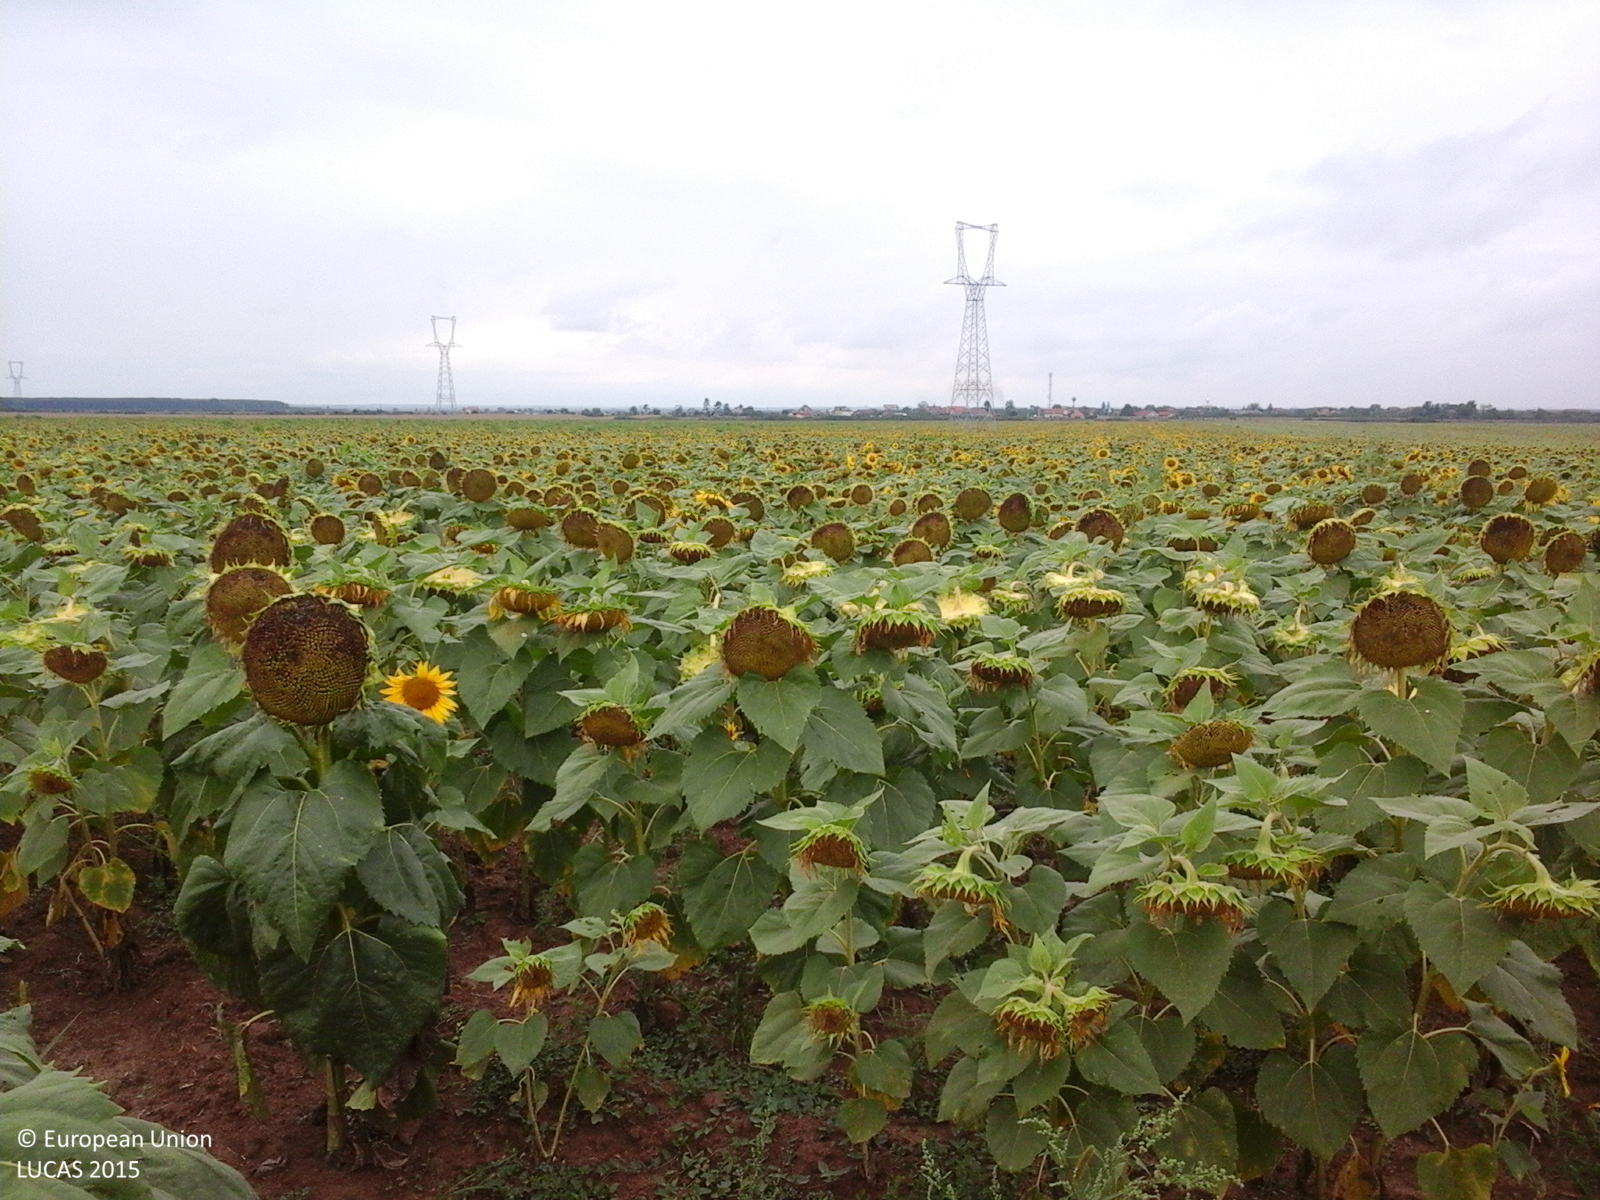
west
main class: Cropland
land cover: Sunflower
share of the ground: > 75 %
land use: Agriculture (excluding fallow land and kitchen gardens)
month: September
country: RO
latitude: 46.9624
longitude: 21.8595
